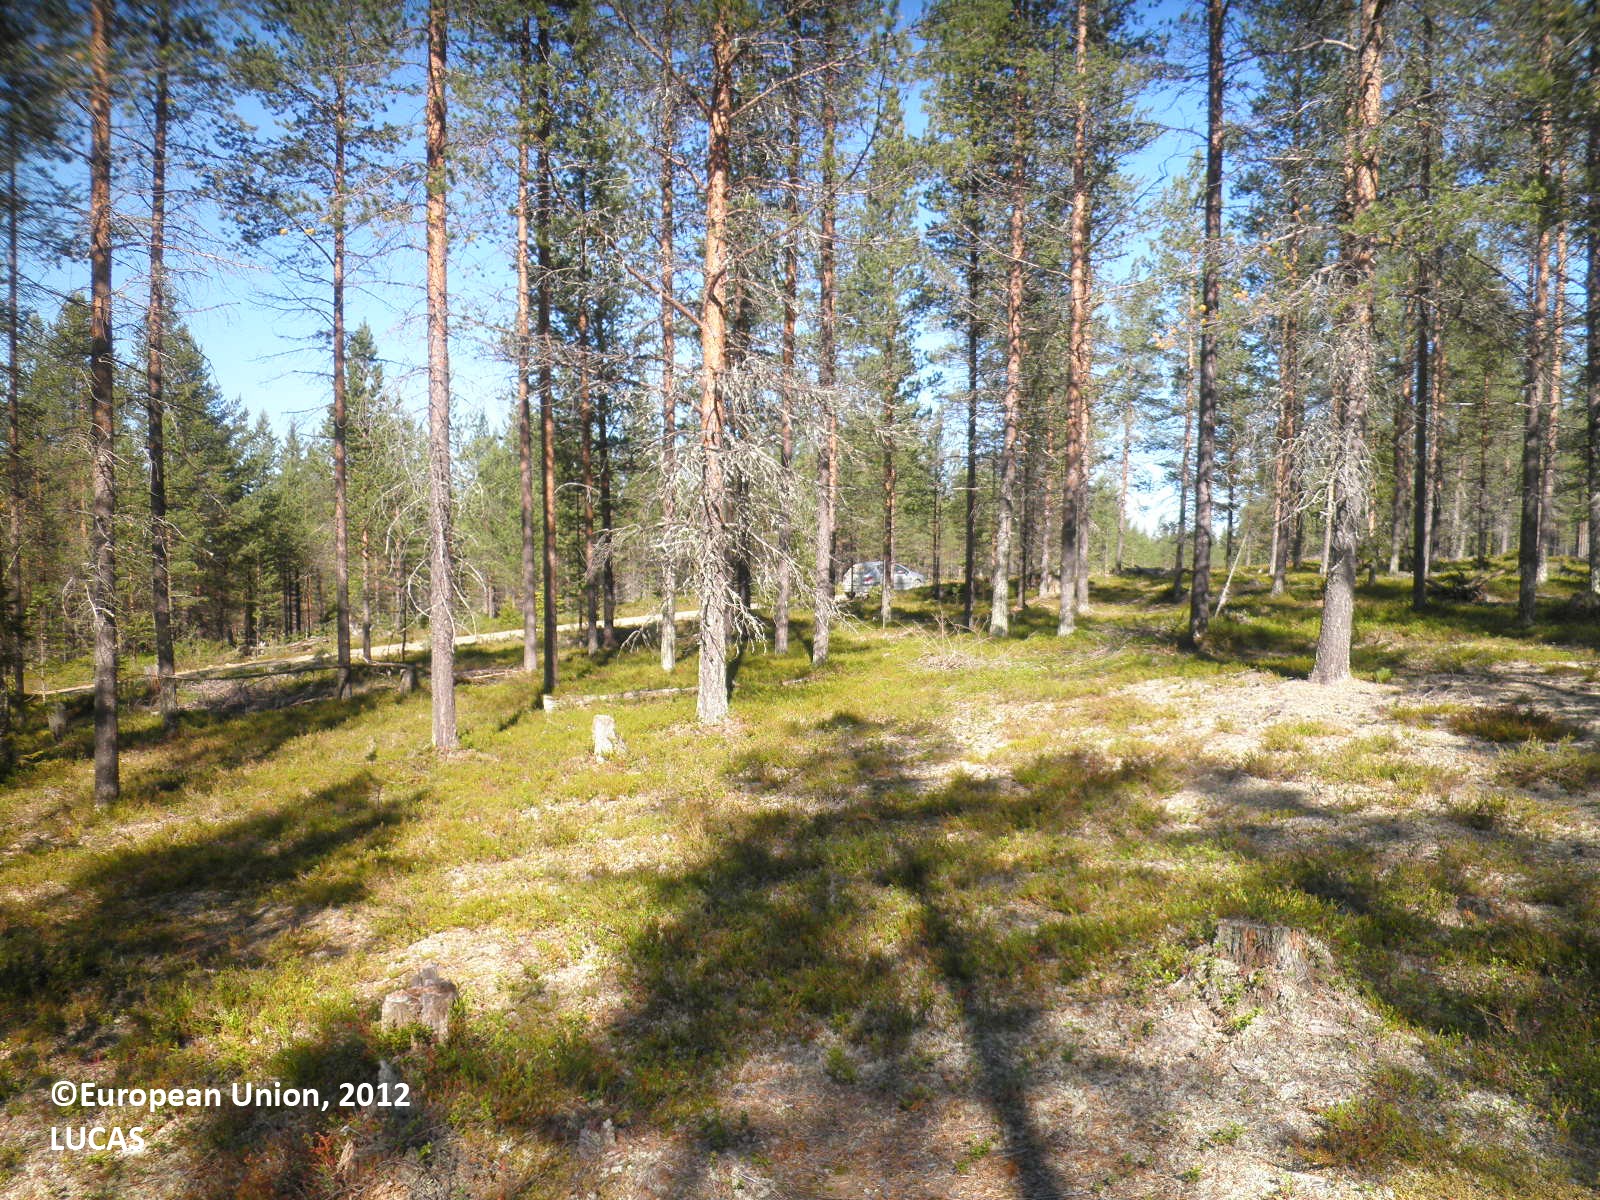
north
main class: Woodland
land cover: Pine dominated coniferous woodland
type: boreal forest
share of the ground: 25 - 50 %
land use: Forestry
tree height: > 5 m
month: August
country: FI
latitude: 67.7313
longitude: 25.6315
